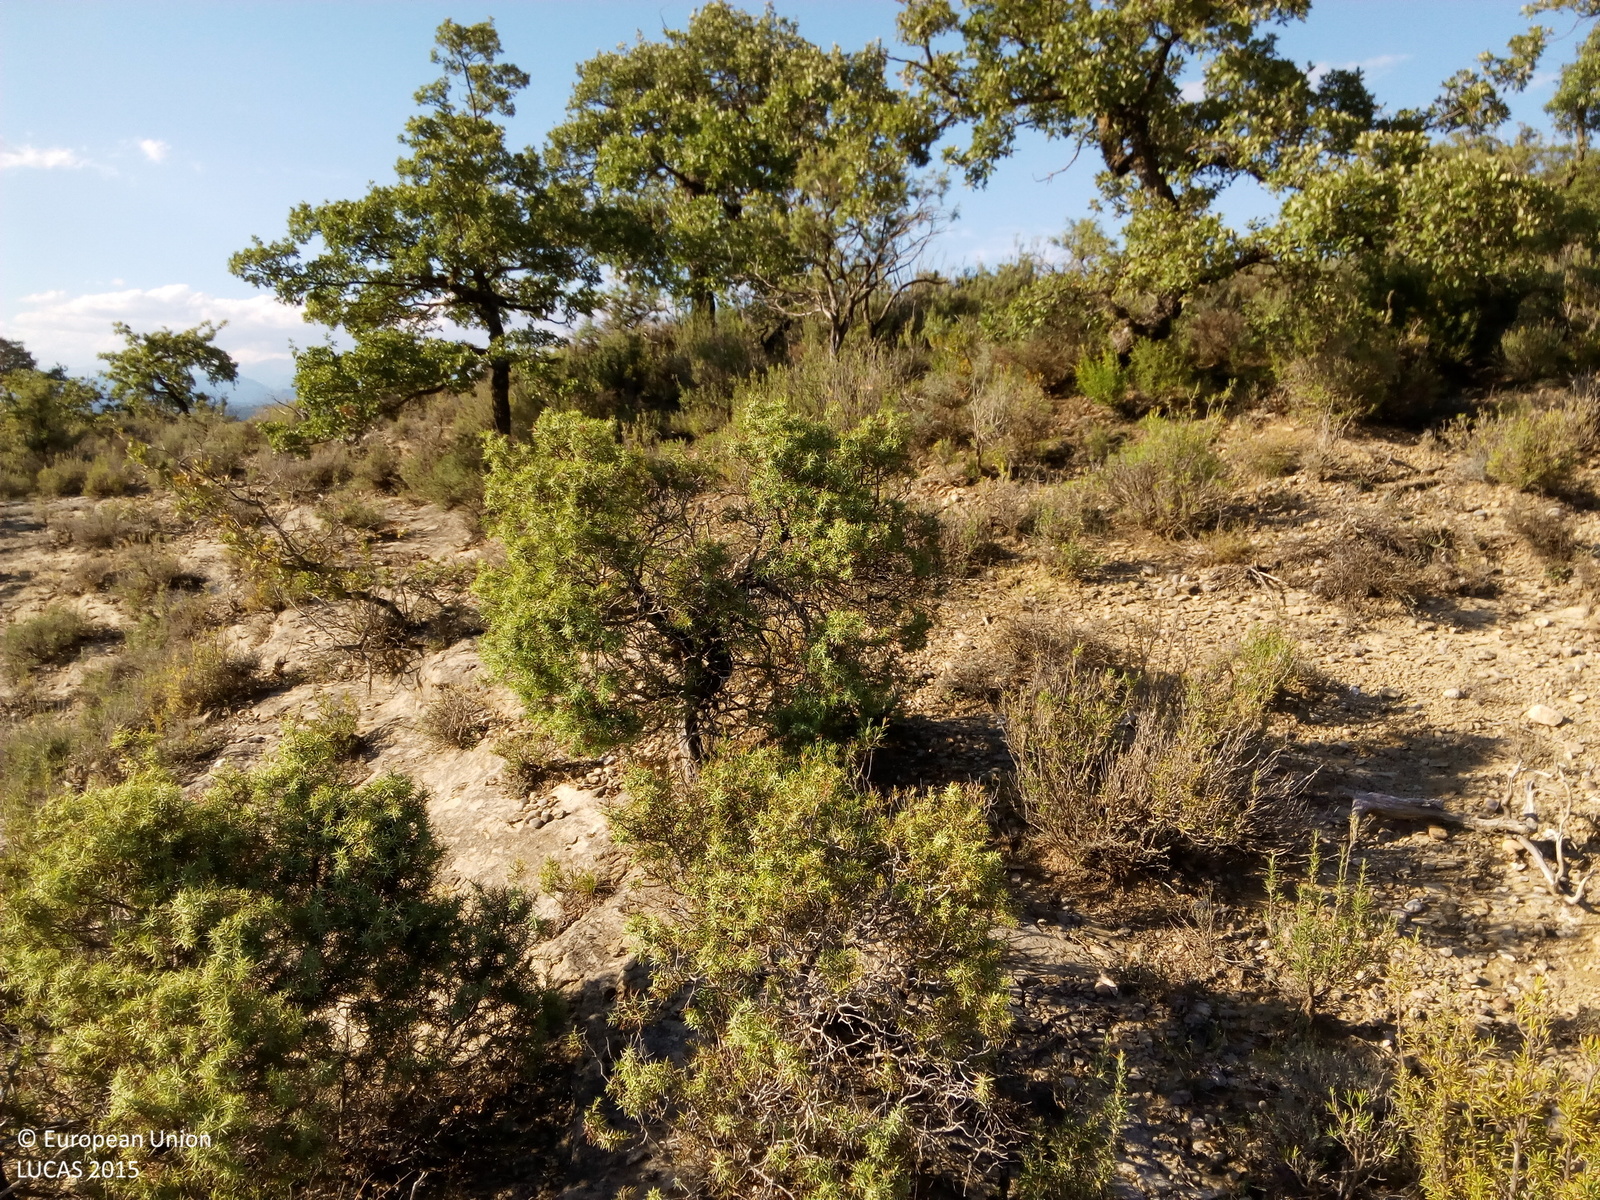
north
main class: Shrubland
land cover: Shrubland with sparse tree cover
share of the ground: > 75 %
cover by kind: consolidated bare surface 50 %, unconsolidated bare surface 30 %, shrubs 15 %, broadleaved forest trees 5 %
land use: Semi-natural and natural areas not in use
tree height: < 5 m
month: August
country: ES
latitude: 42.1840
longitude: 0.4536
